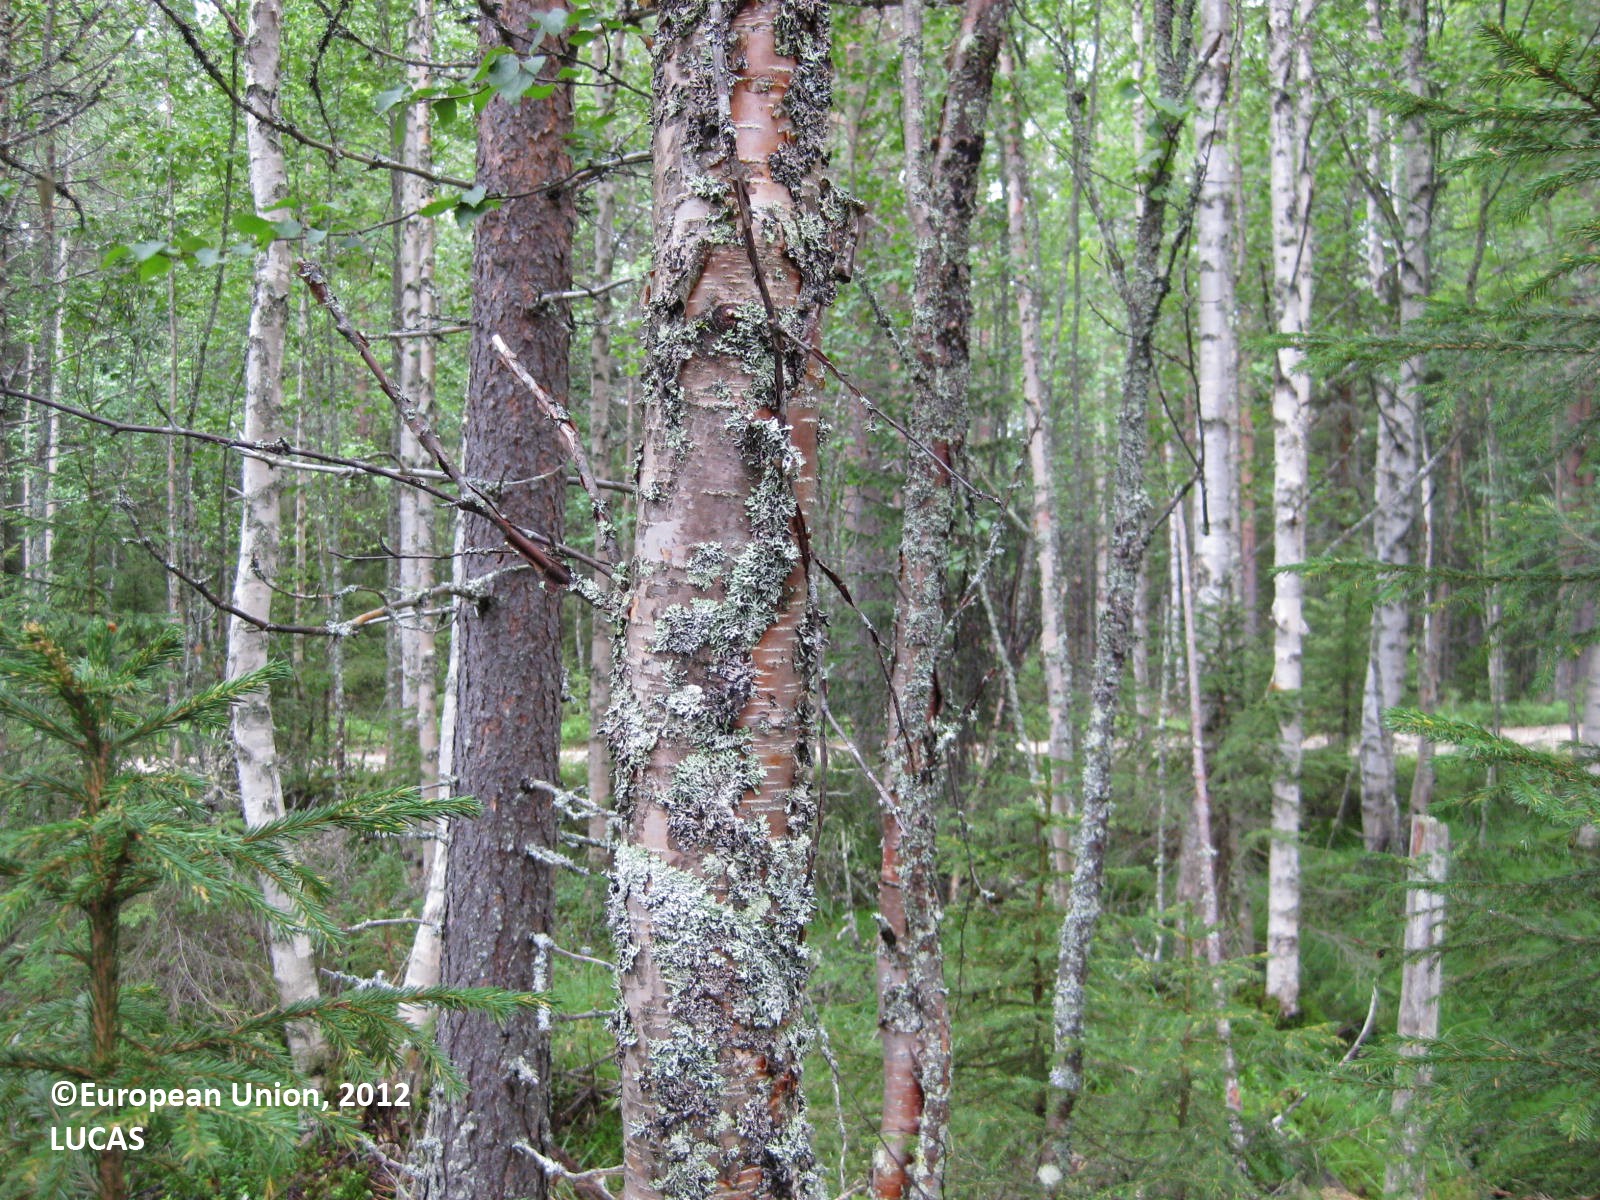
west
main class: Woodland
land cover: Pine dominated mixed woodland
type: boreal forest
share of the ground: > 75 %
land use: Forestry
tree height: > 5 m
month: August
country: FI
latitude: 66.0846
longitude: 28.2951
